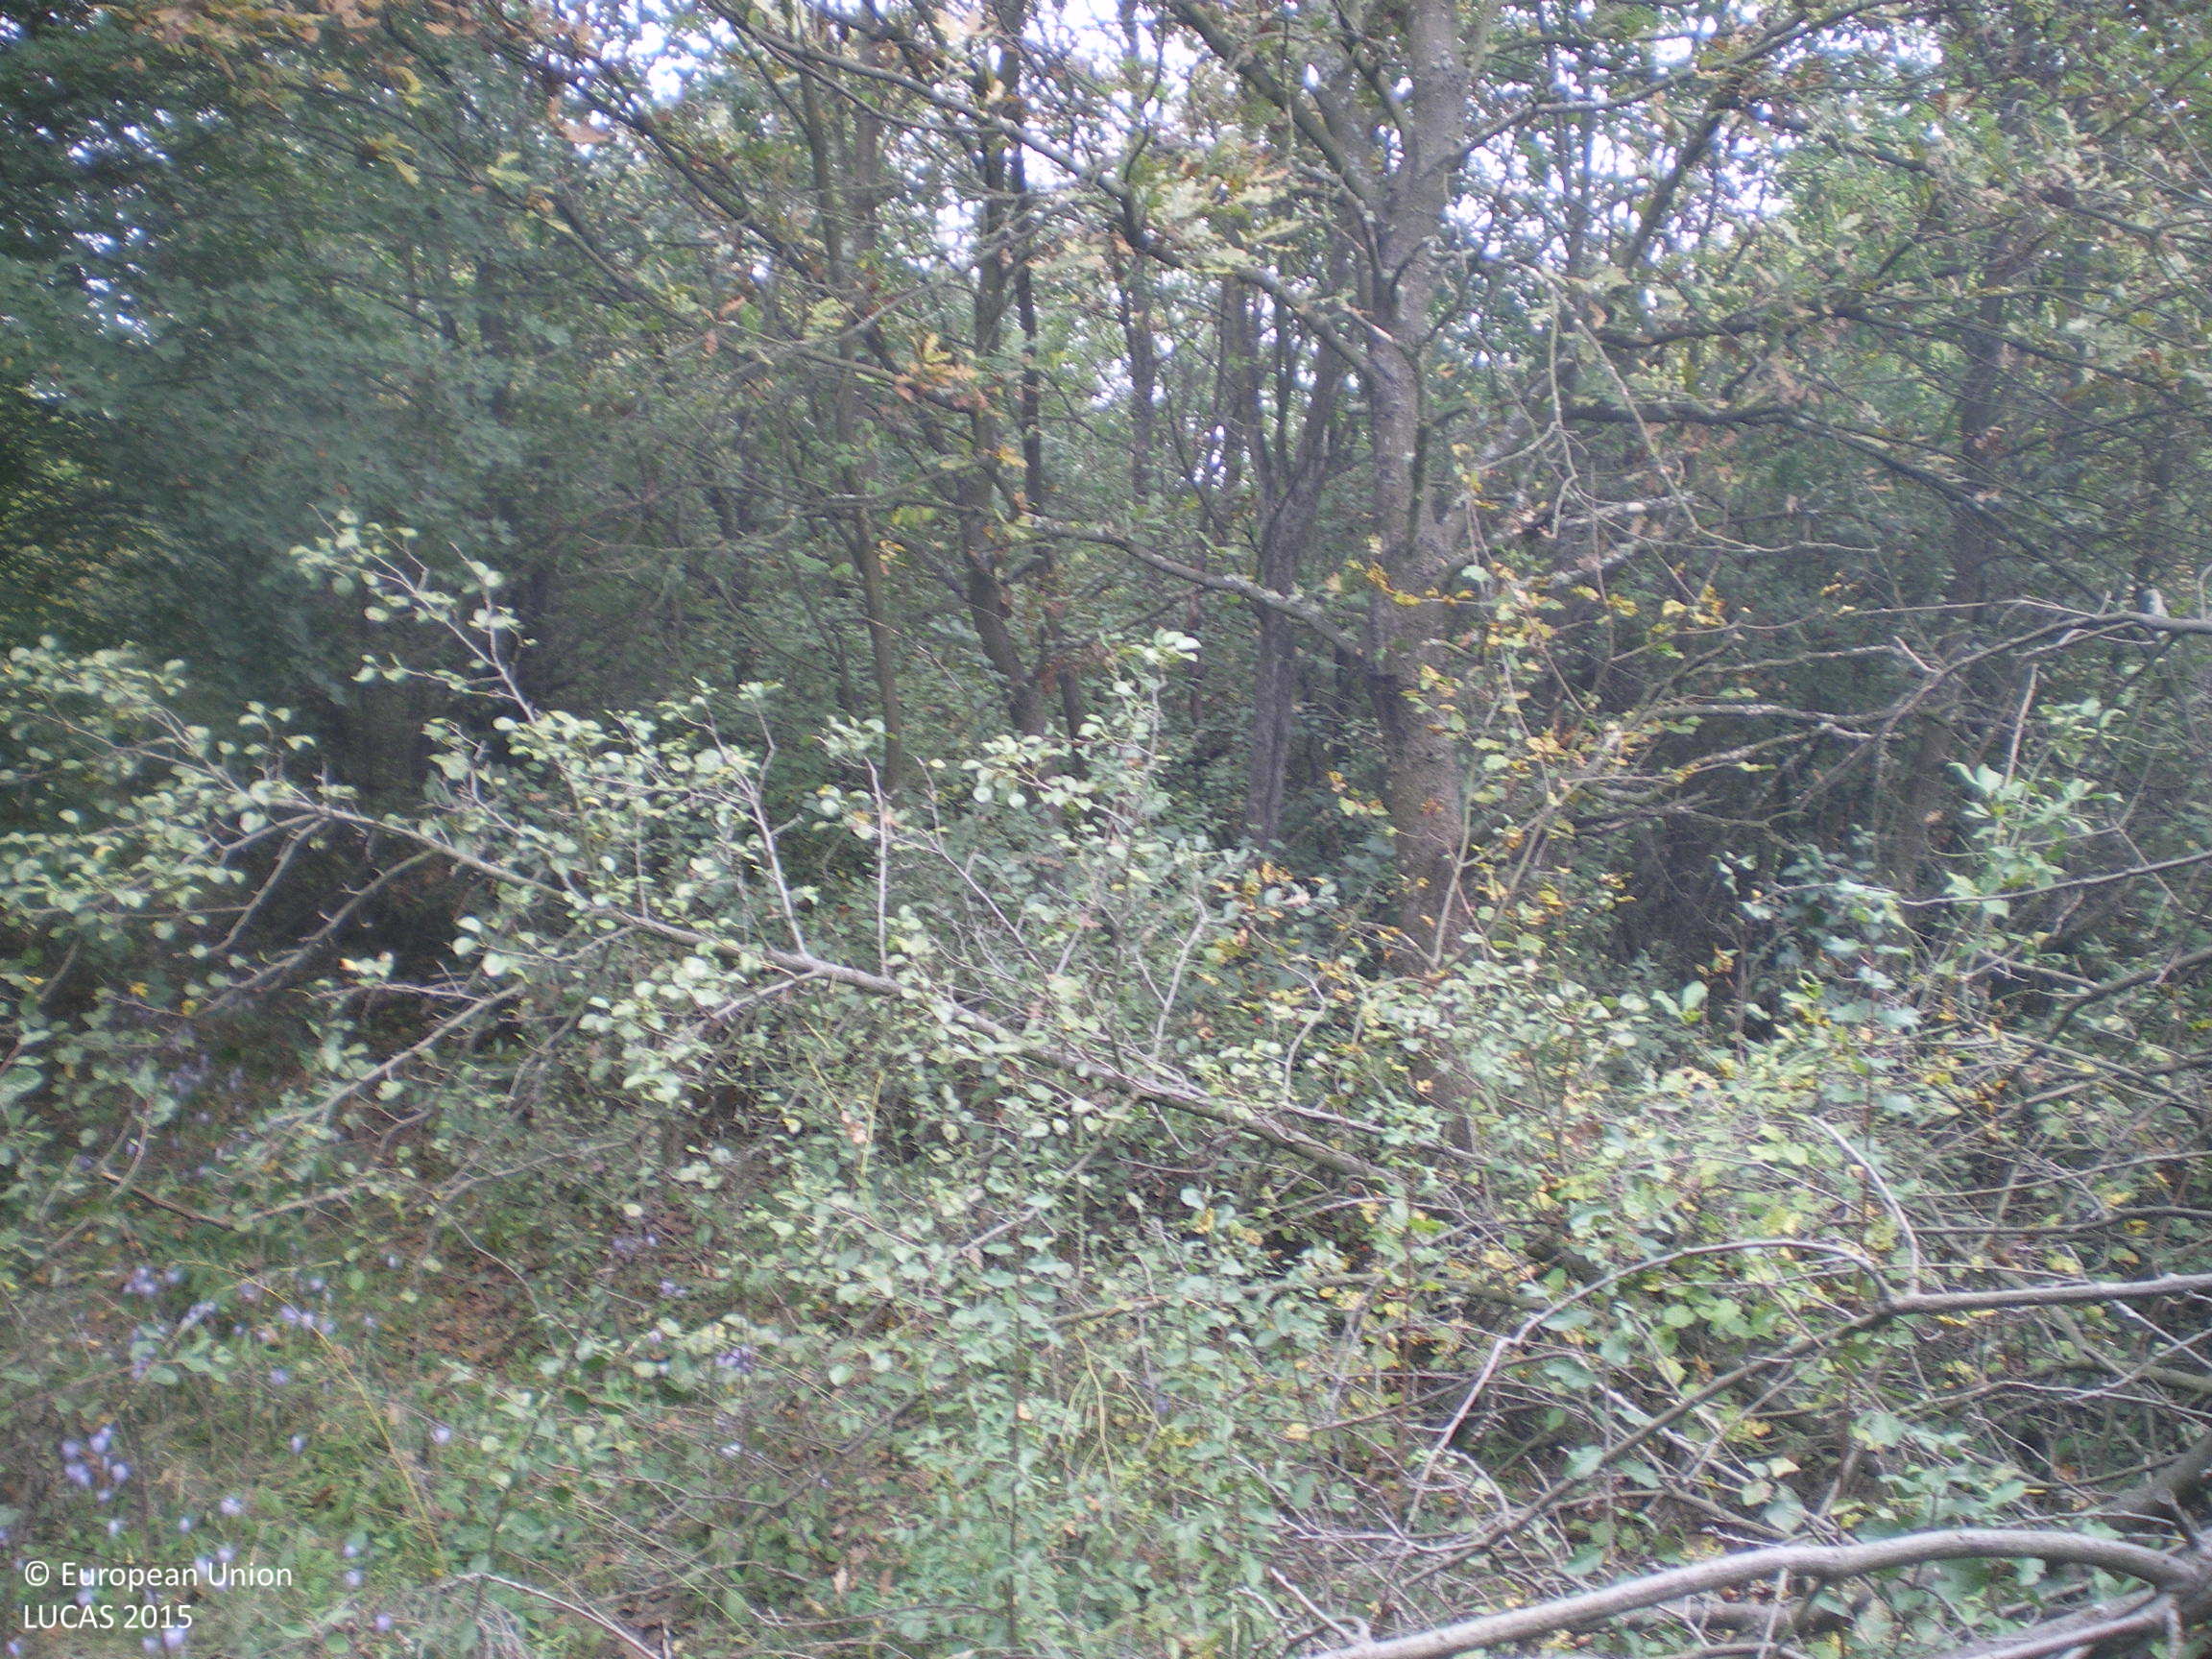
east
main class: Woodland
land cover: Broadleaved woodland
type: mesophytic deciduous forest
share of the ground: > 75 %
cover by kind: broadleaved forest trees 95 %, unconsolidated bare surface 5 %
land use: Forestry
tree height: > 5 m
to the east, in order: Broadleaved woodland; Tracks; Broadleaved woodland
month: October
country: BG
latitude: 42.0531
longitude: 25.7657
